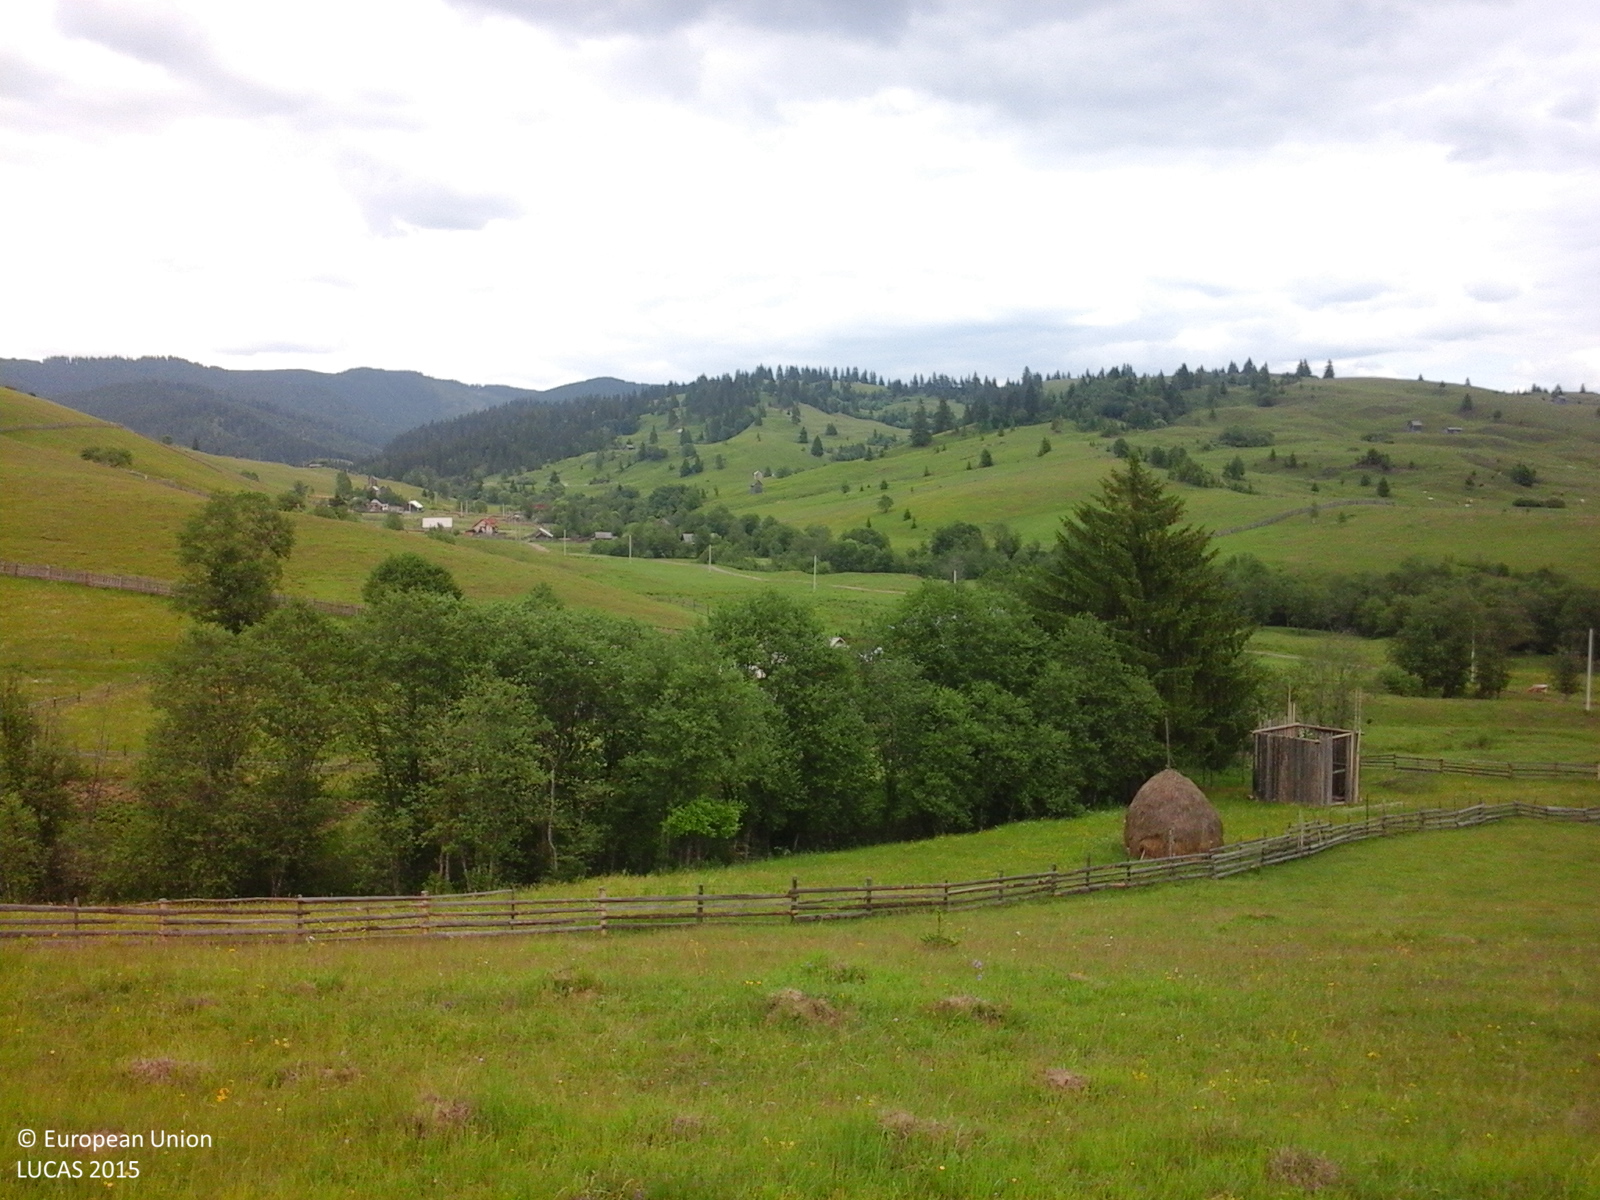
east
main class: Grassland
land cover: Grassland without tree/shrub cover
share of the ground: > 75 %
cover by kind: herbaceous plants 100 %
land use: Agriculture (excluding fallow land and kitchen gardens)
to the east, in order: Grassland without tree/shrub cover; Fences; Grassland without tree/shrub cover; Lines of trees; Artificial constructions in urban areas; Apple fruit; Fences; Grassland without tree/shrub cover; Fences; Tracks; Fences; Grassland without tree/shrub cover
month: June
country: RO
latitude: 47.6130
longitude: 25.3732
